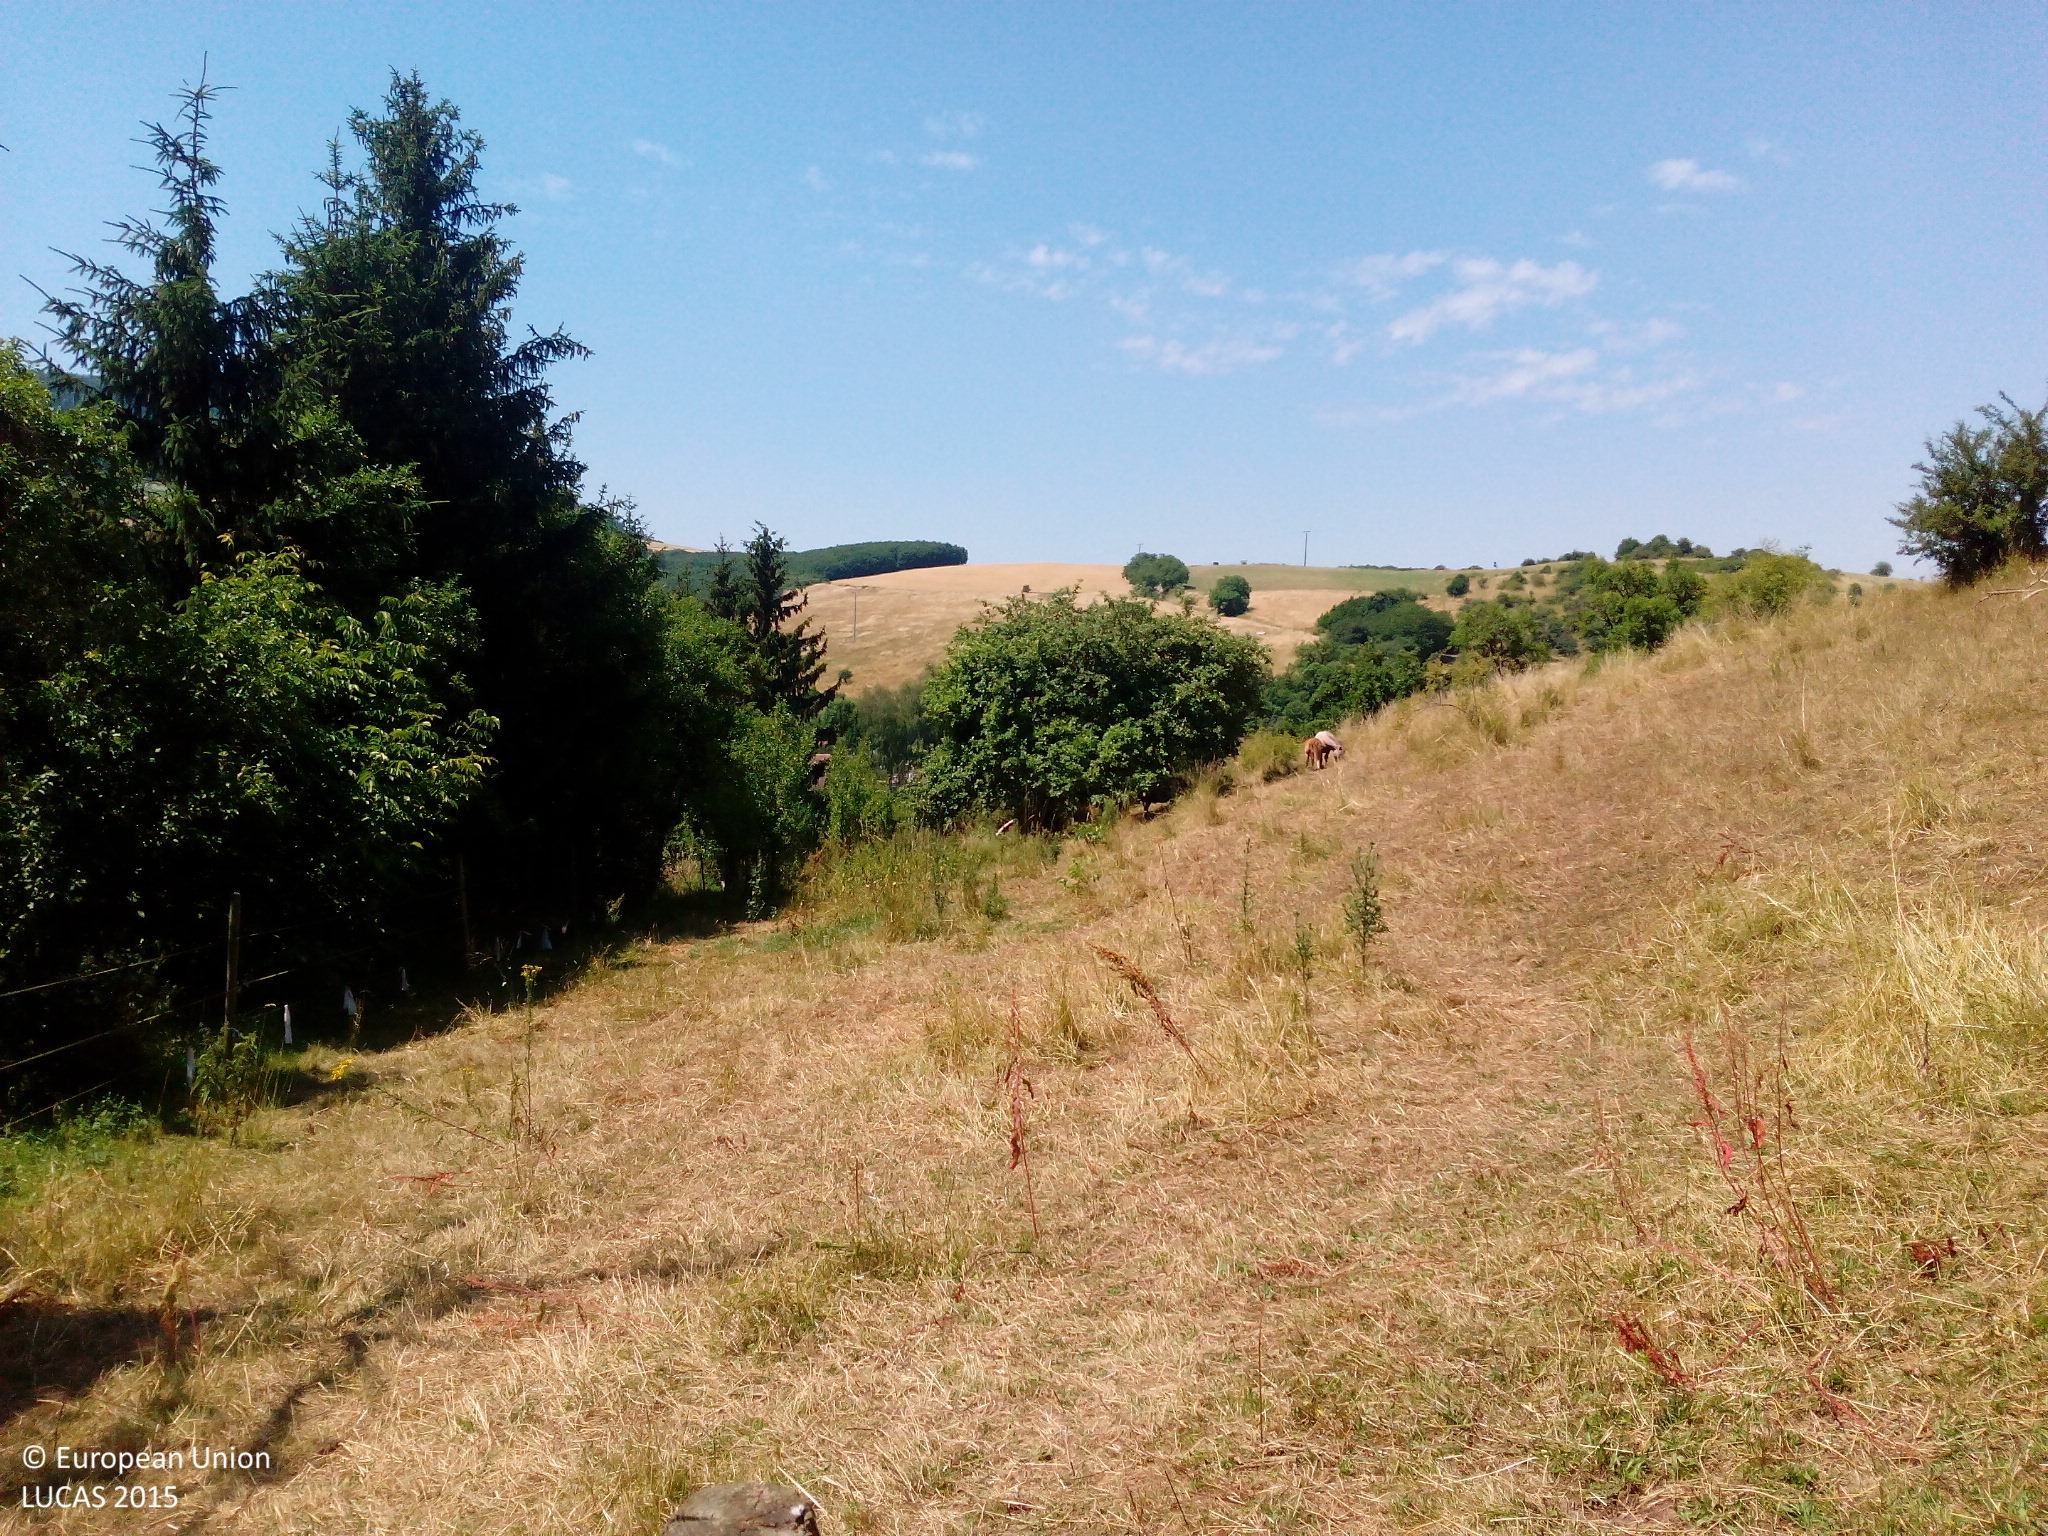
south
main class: Grassland
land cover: Grassland with sparse tree/shrub cover
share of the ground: > 75 %
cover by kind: herbaceous plants 80 %, unconsolidated bare surface 10 %, broadleaved forest trees 5 %, shrubs 5 %
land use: Agriculture (excluding fallow land and kitchen gardens)
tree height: < 5 m
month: July
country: DE
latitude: 49.5823
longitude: 7.5523
